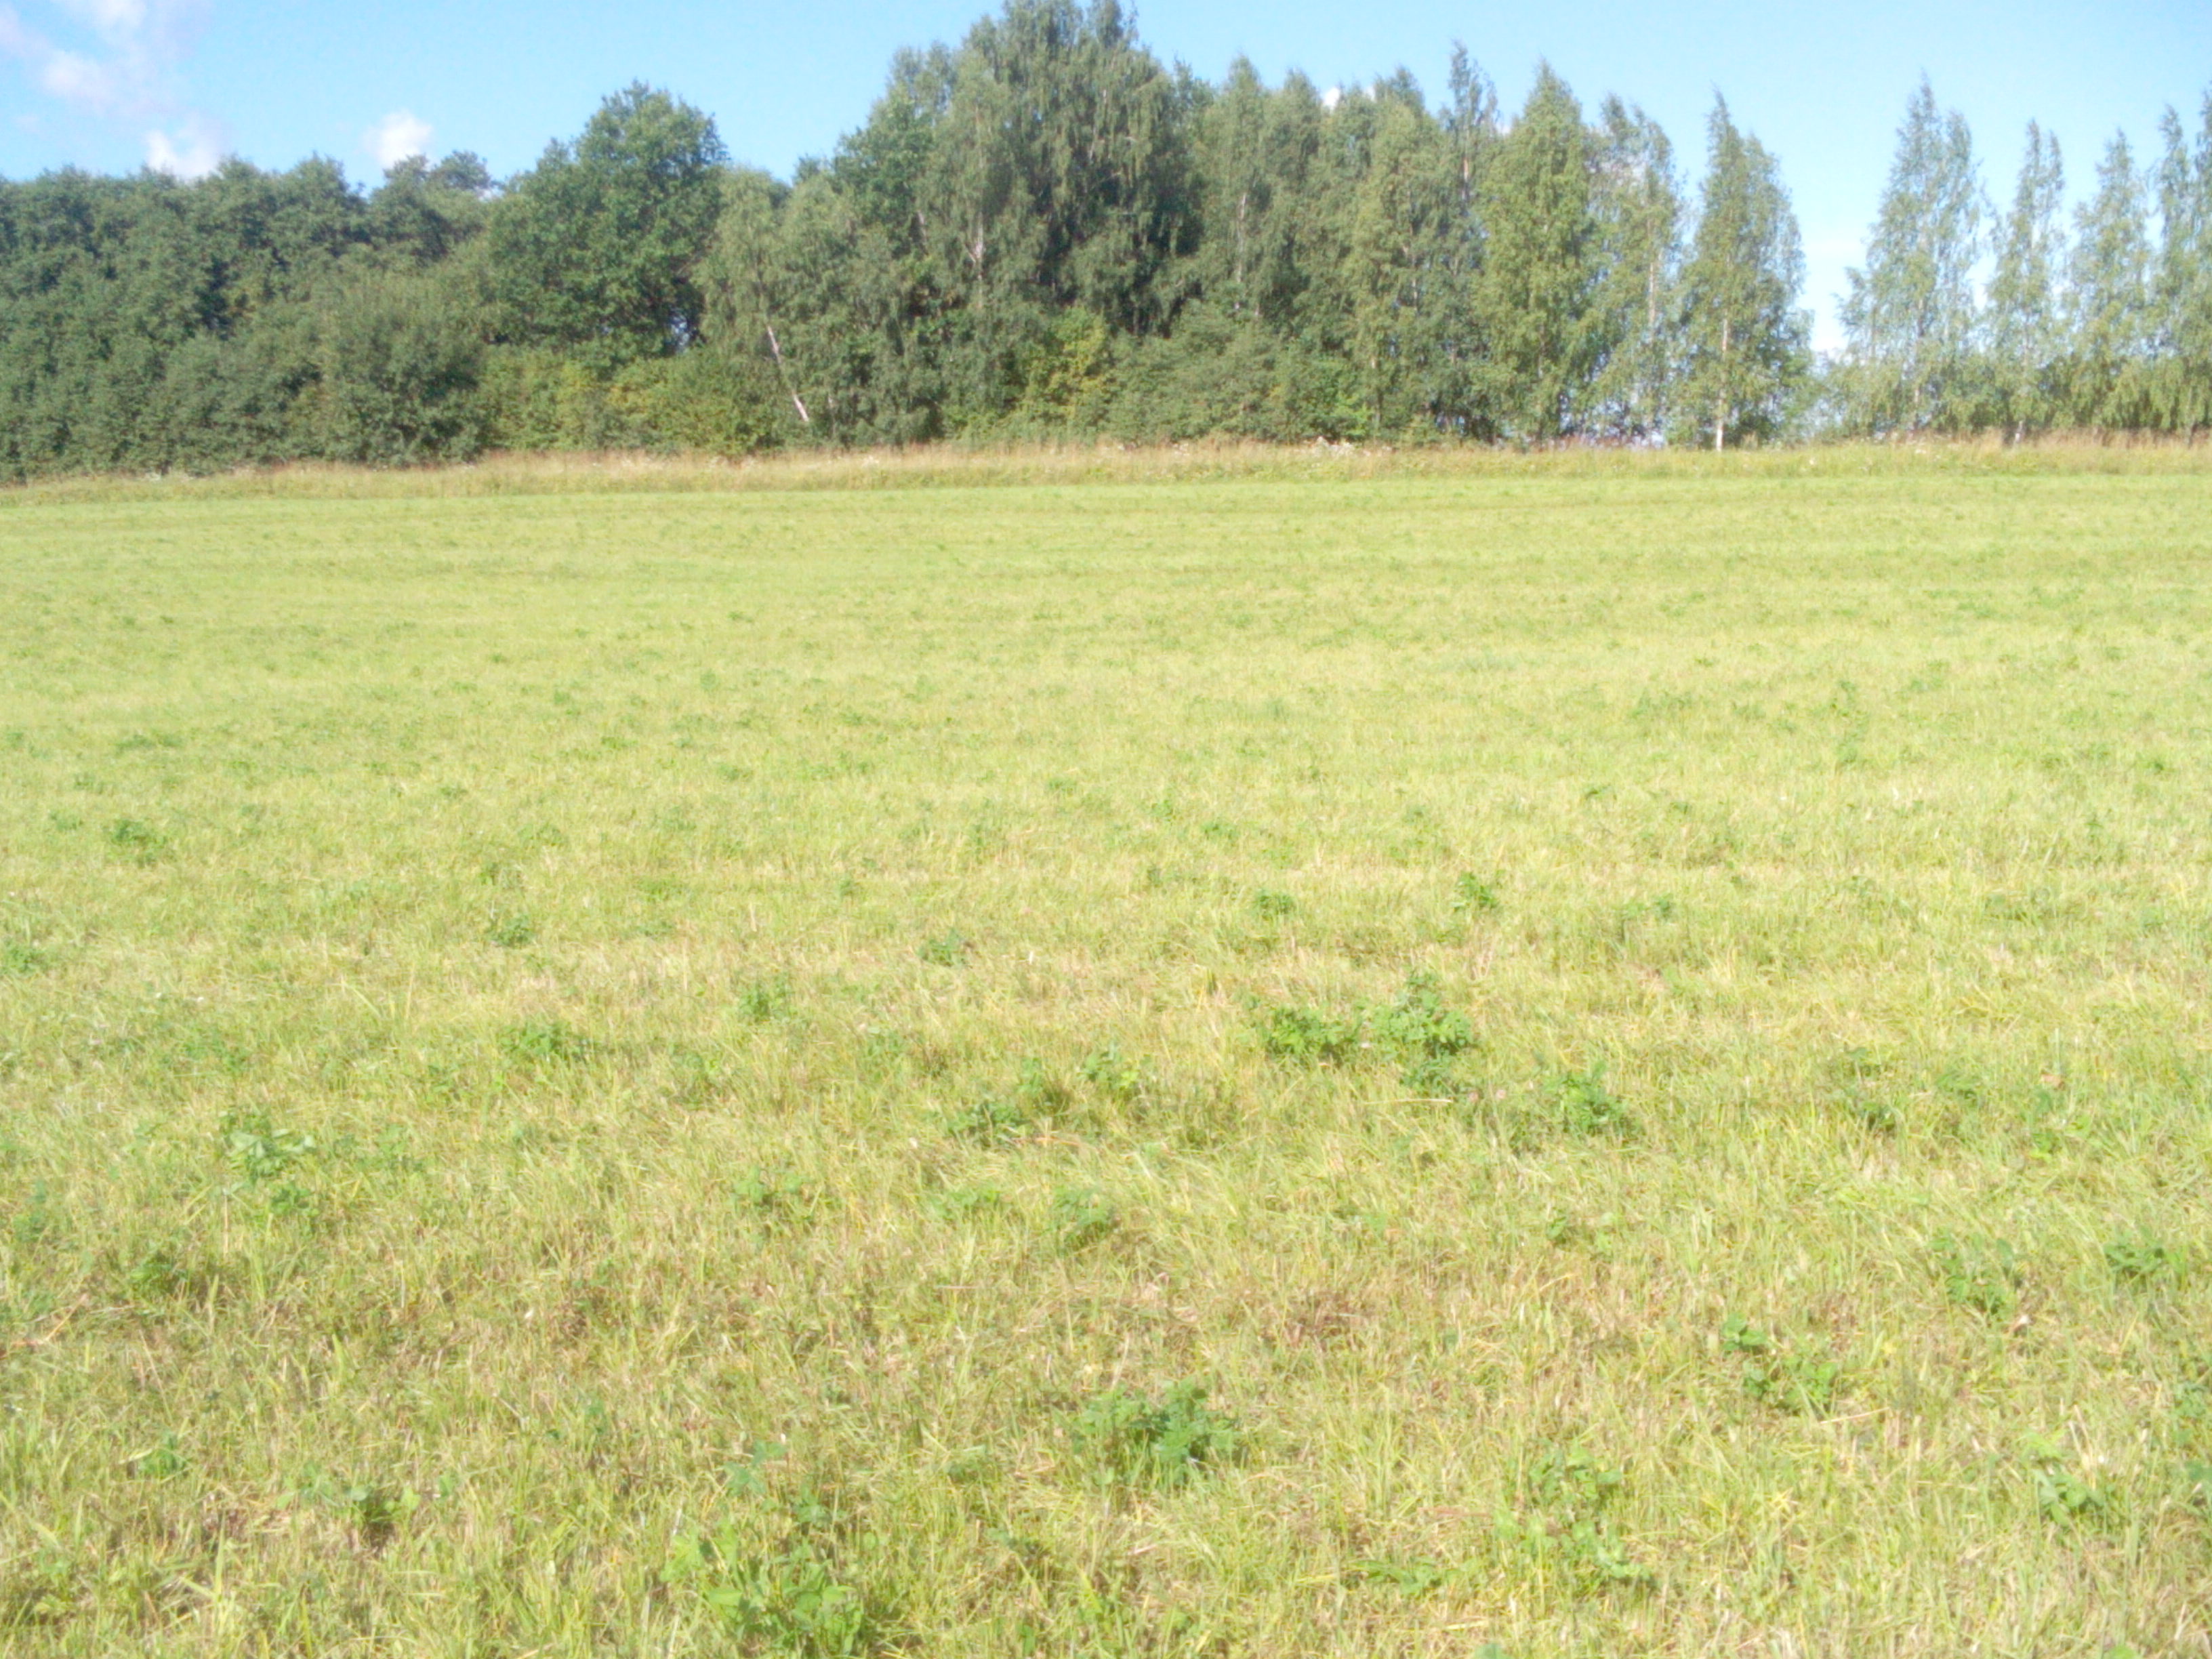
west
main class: Grassland
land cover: Grassland without tree/shrub cover
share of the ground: > 75 %
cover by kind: herbaceous plants 100 %
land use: Agriculture (excluding fallow land and kitchen gardens)
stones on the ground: < 10 %
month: August
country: LV
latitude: 56.4900
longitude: 21.2616
